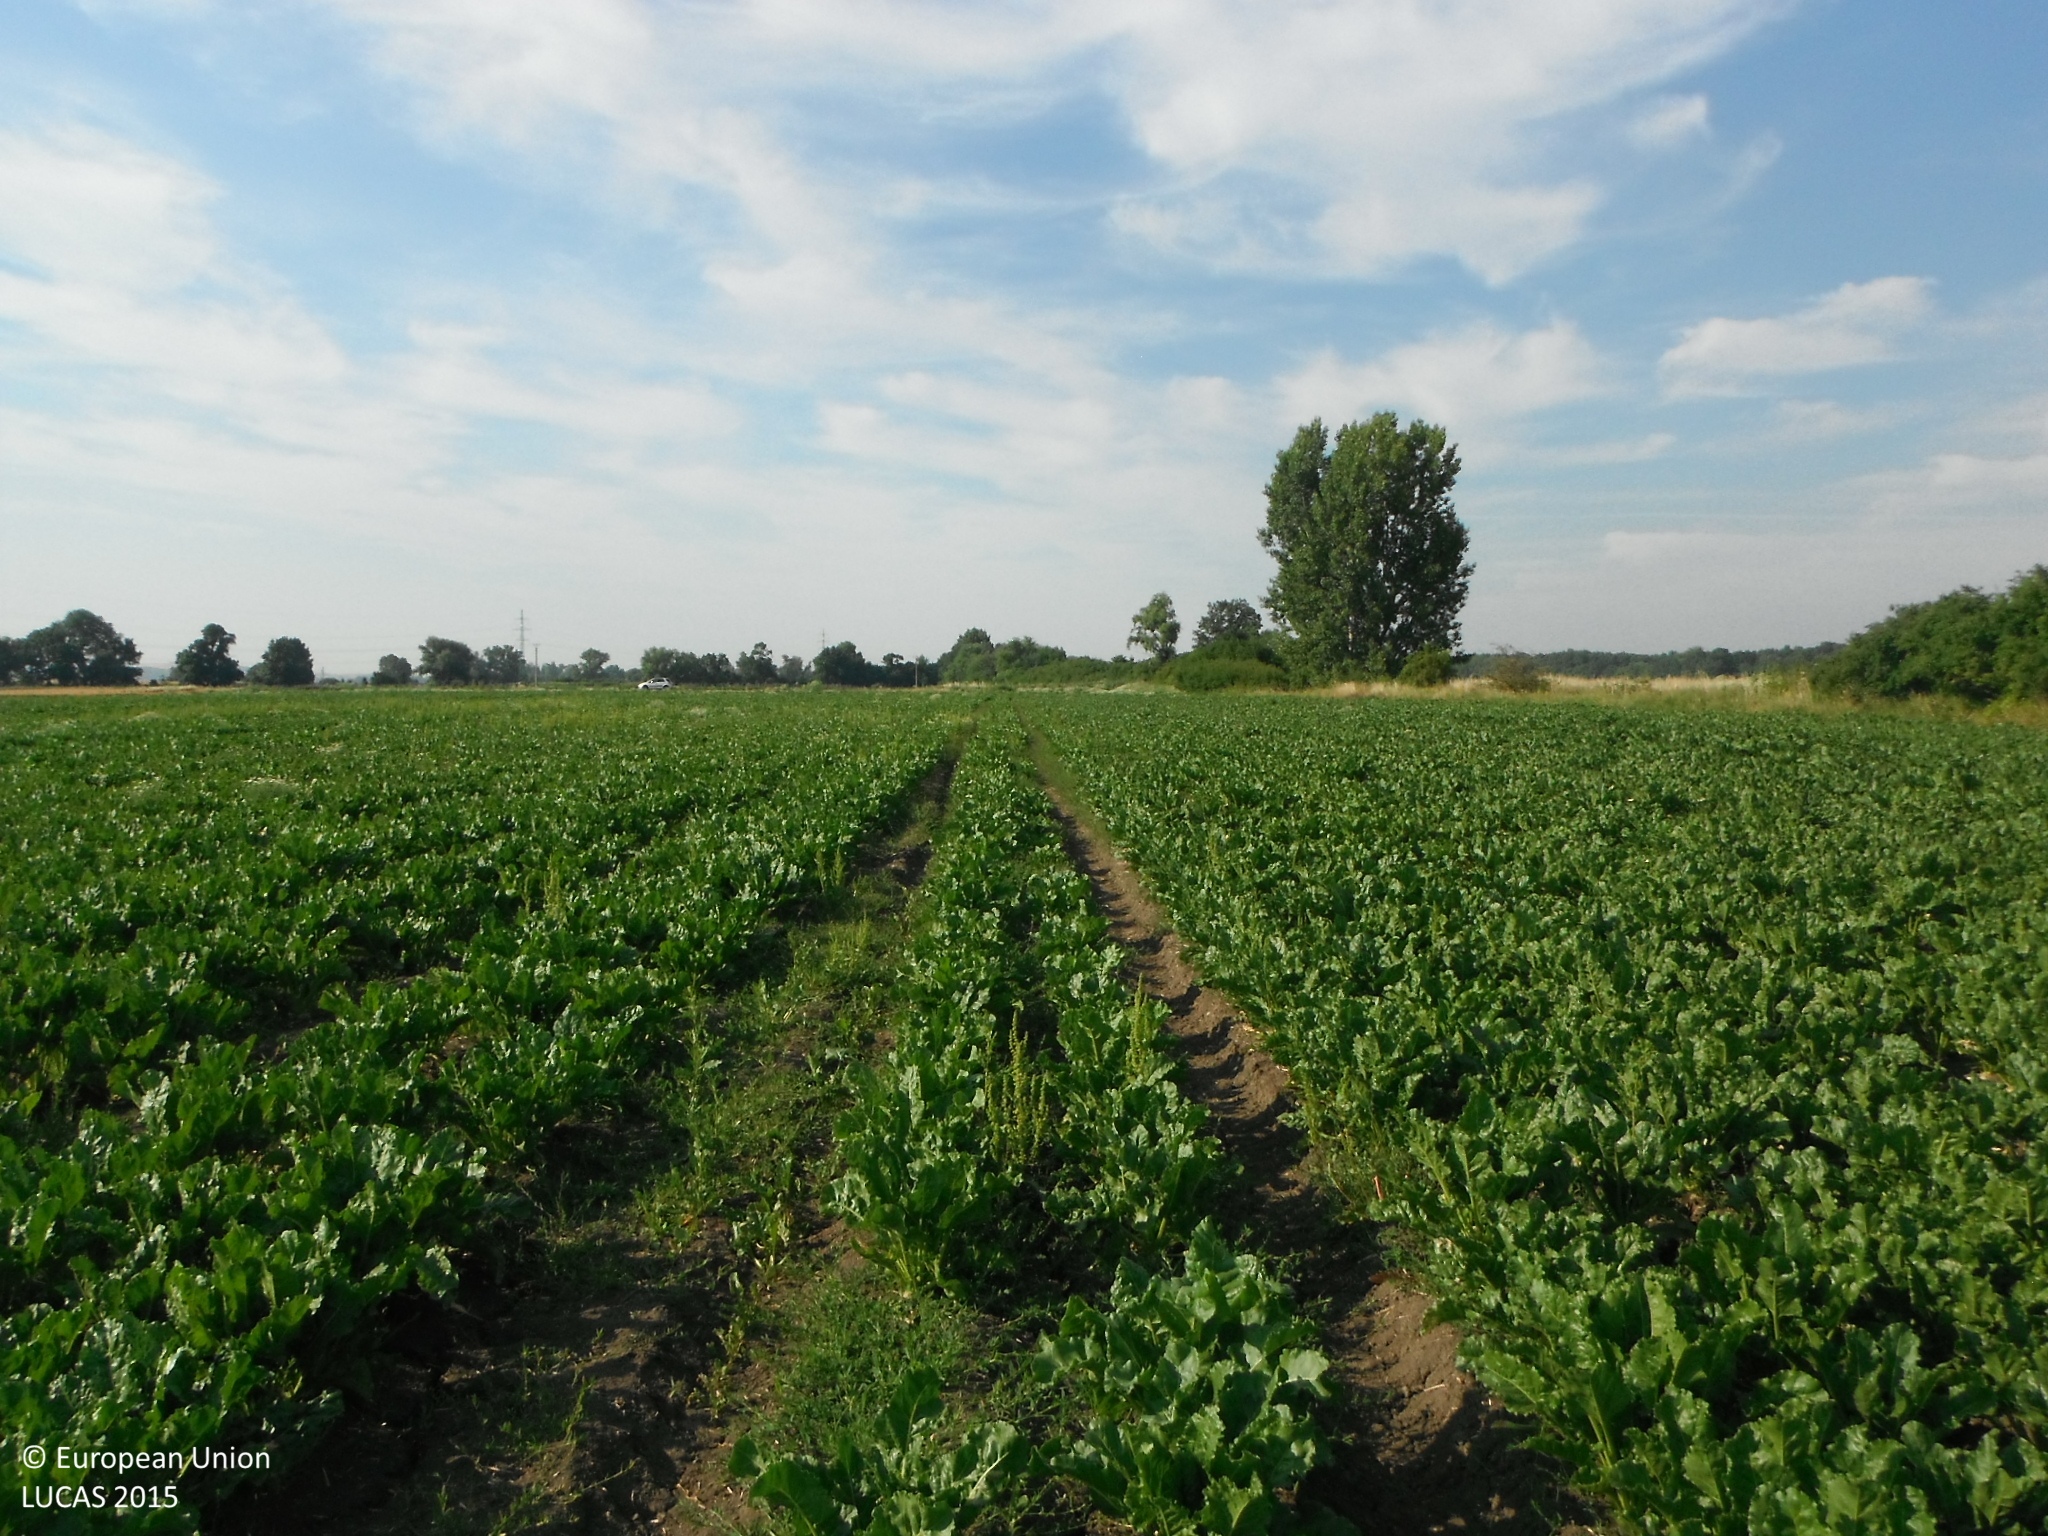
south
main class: Cropland
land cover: Sugar beet
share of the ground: > 75 %
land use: Agriculture (excluding fallow land and kitchen gardens)
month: June
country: SK
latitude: 48.4220
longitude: 17.7277
